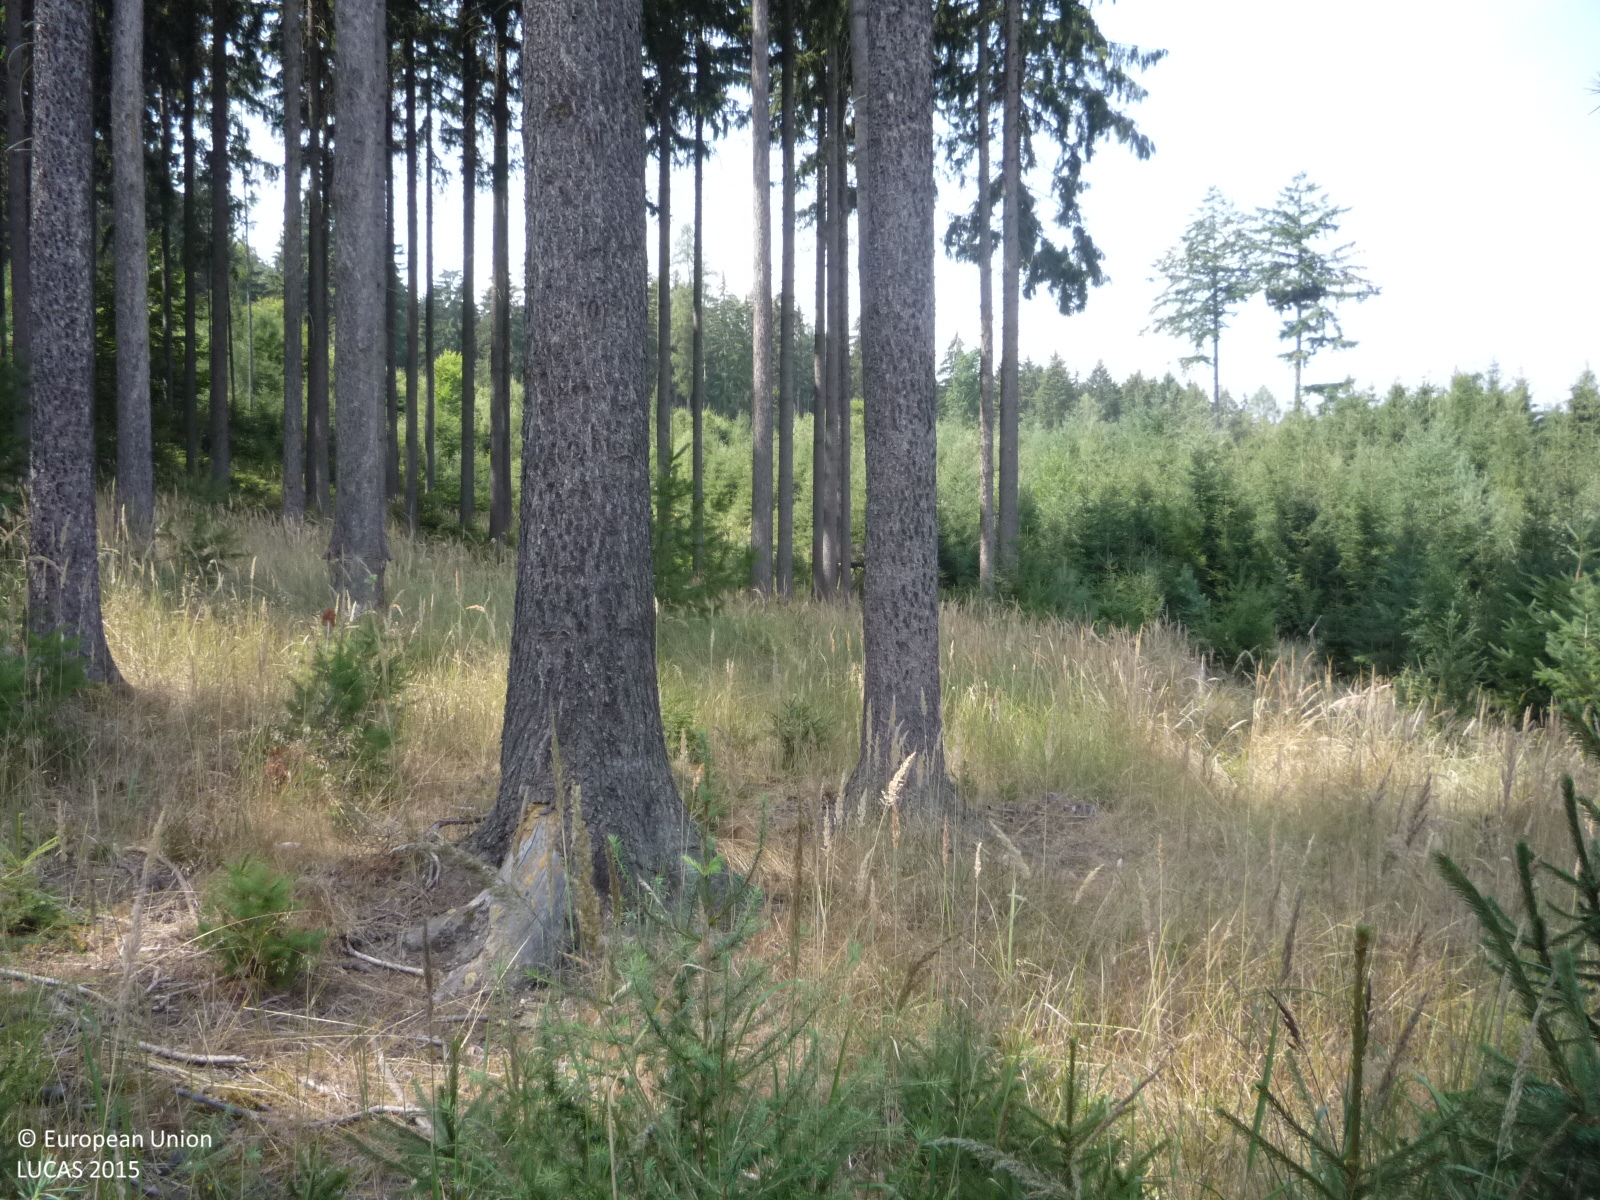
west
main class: Woodland
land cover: Spruce dominated coniferous woodland
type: hemiboreal forest and nemoral coniferous forest and mixed broadleaved-coniferous forest
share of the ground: > 75 %
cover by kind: coniferous forest trees 70 %, herbaceous plants 20 %, broadleaved forest trees 10 %
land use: Forestry
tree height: < 5 m
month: August
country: CZ
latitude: 49.8436
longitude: 14.4932
